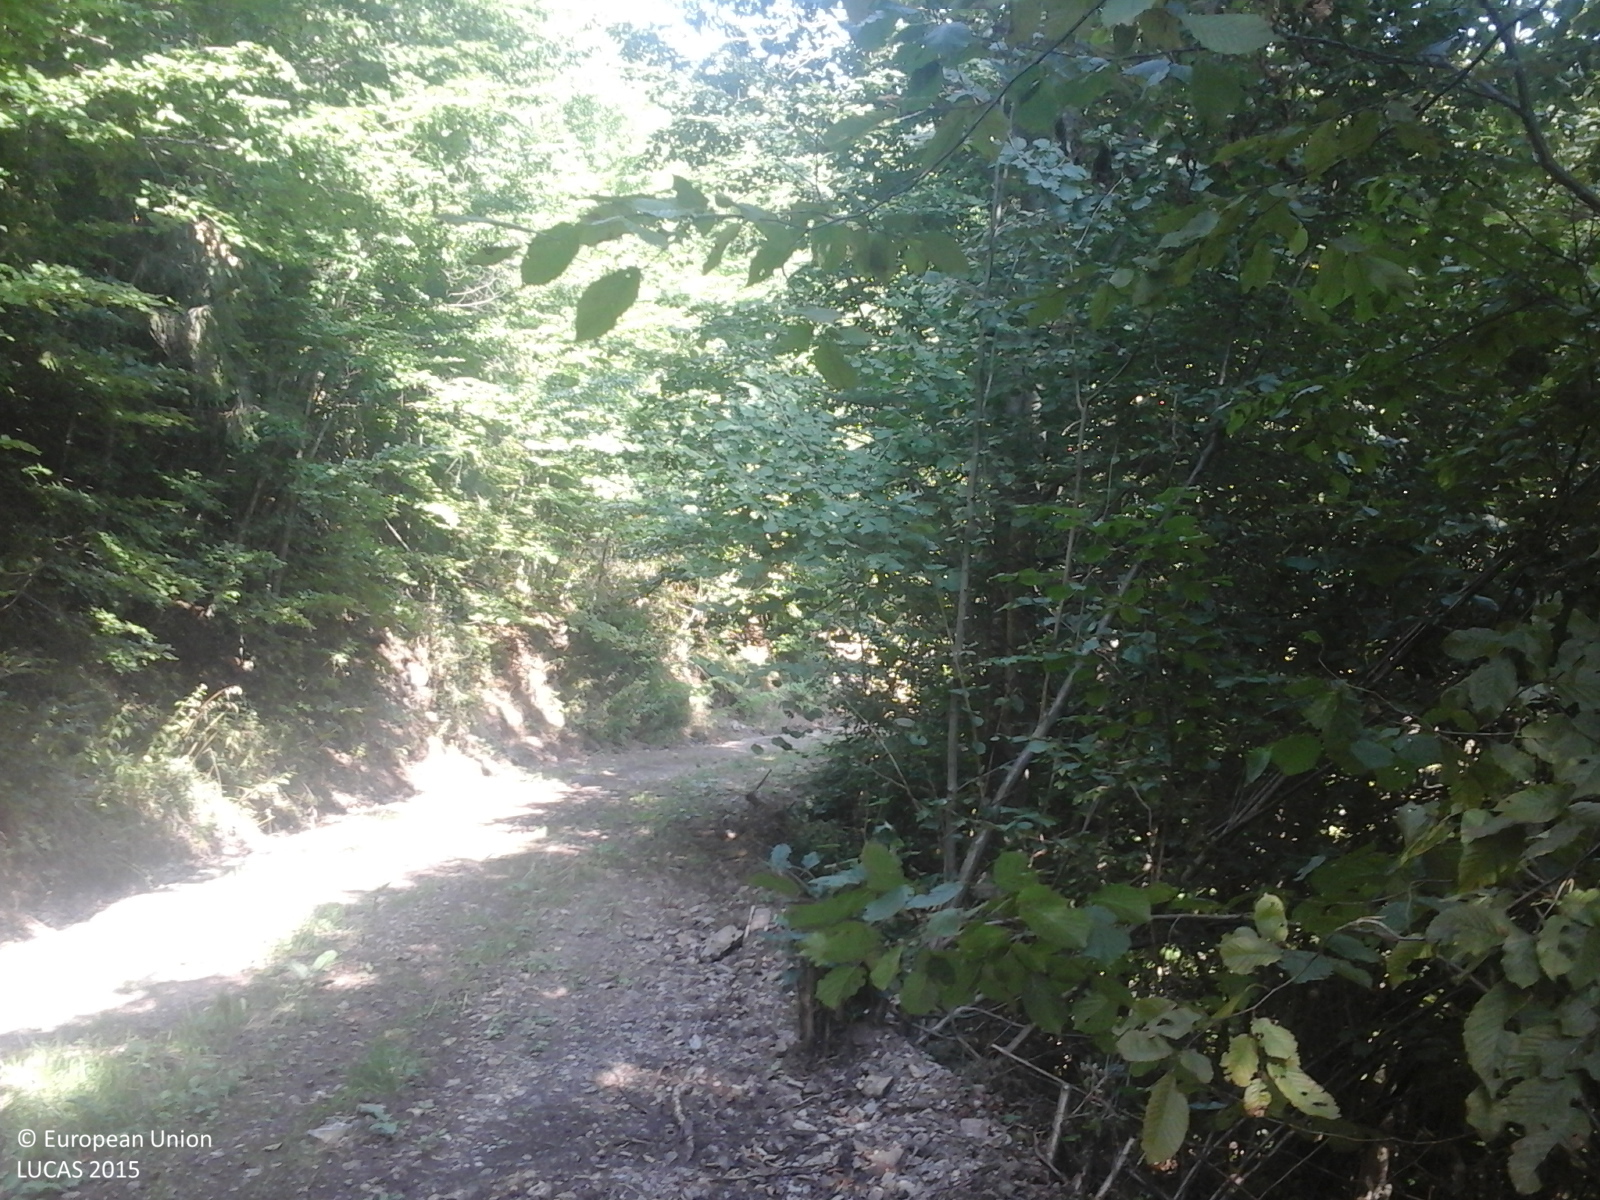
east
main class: Woodland
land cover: Broadleaved woodland
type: beech forest
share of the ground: > 75 %
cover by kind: broadleaved forest trees 100 %
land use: Forestry
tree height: > 5 m
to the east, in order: Broadleaved woodland; Shruby margins; Tracks; Grass margins; Other mixed woodland
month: August
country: RO
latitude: 46.4340
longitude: 22.3475
